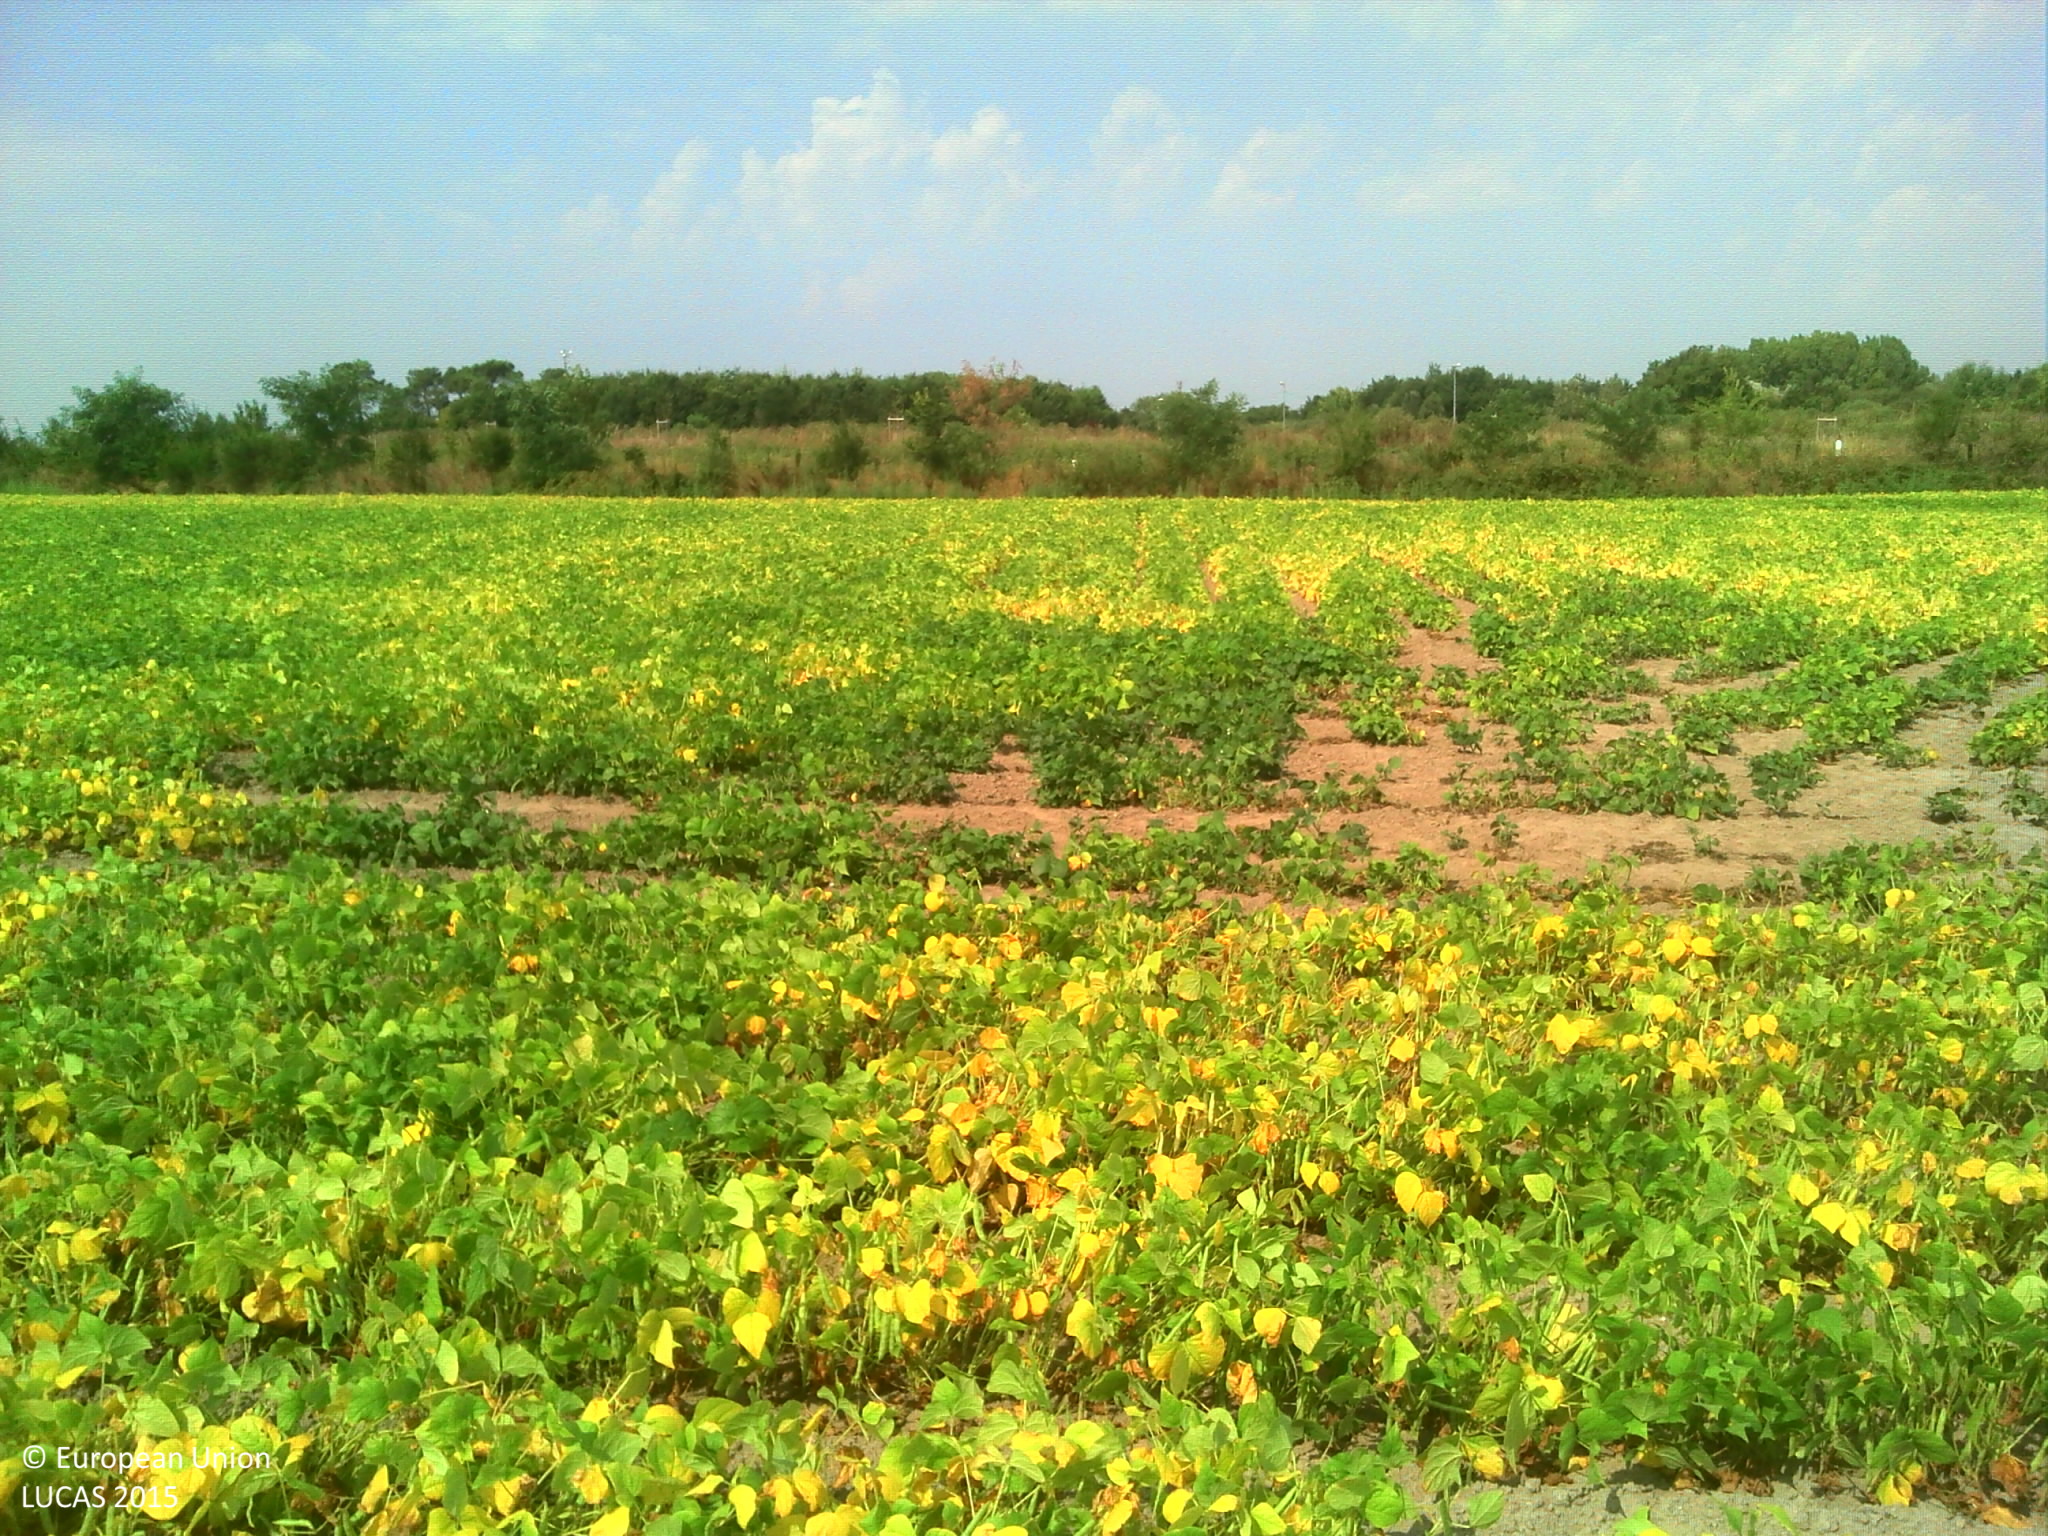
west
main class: Cropland
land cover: Dry pulses
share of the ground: > 75 %
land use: Agriculture (excluding fallow land and kitchen gardens)
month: August
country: FR
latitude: 46.7047
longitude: -1.7216
